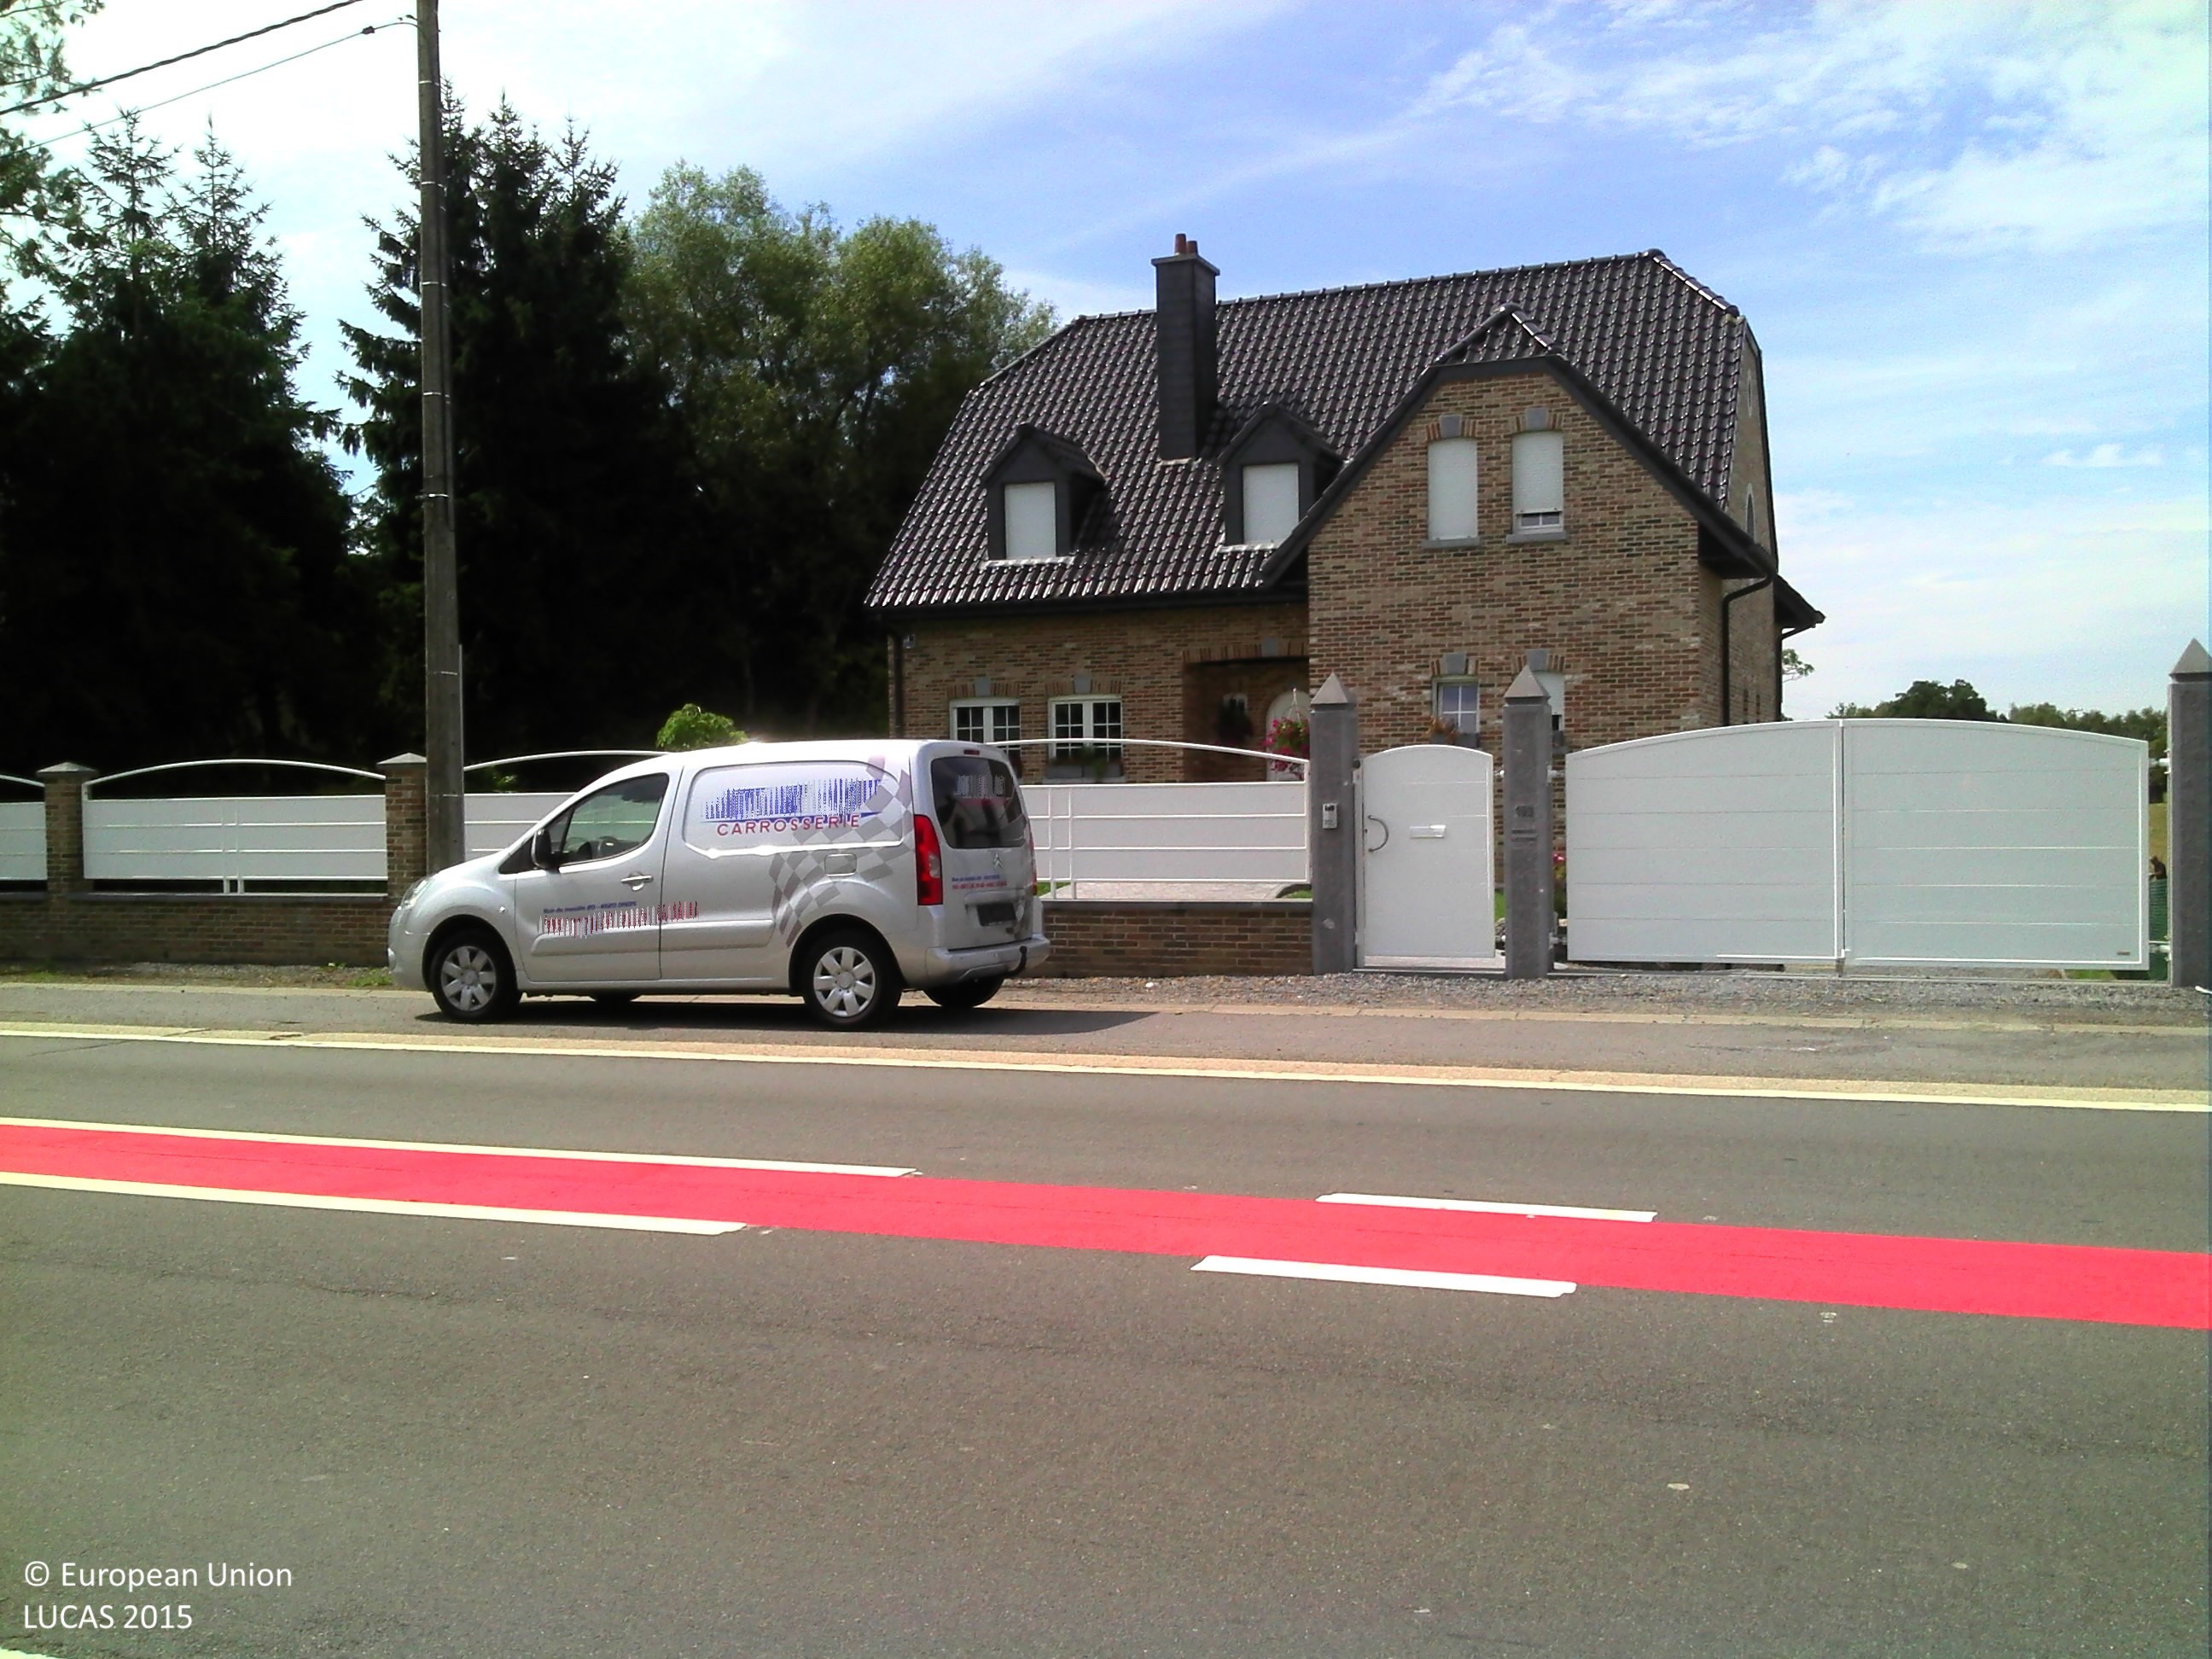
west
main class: Grassland
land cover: Grassland with sparse tree/shrub cover
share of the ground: > 75 %
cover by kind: herbaceous plants 95 %, coniferous forest trees 5 %
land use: Residential
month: July
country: BE
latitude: 50.5593
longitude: 5.8628
